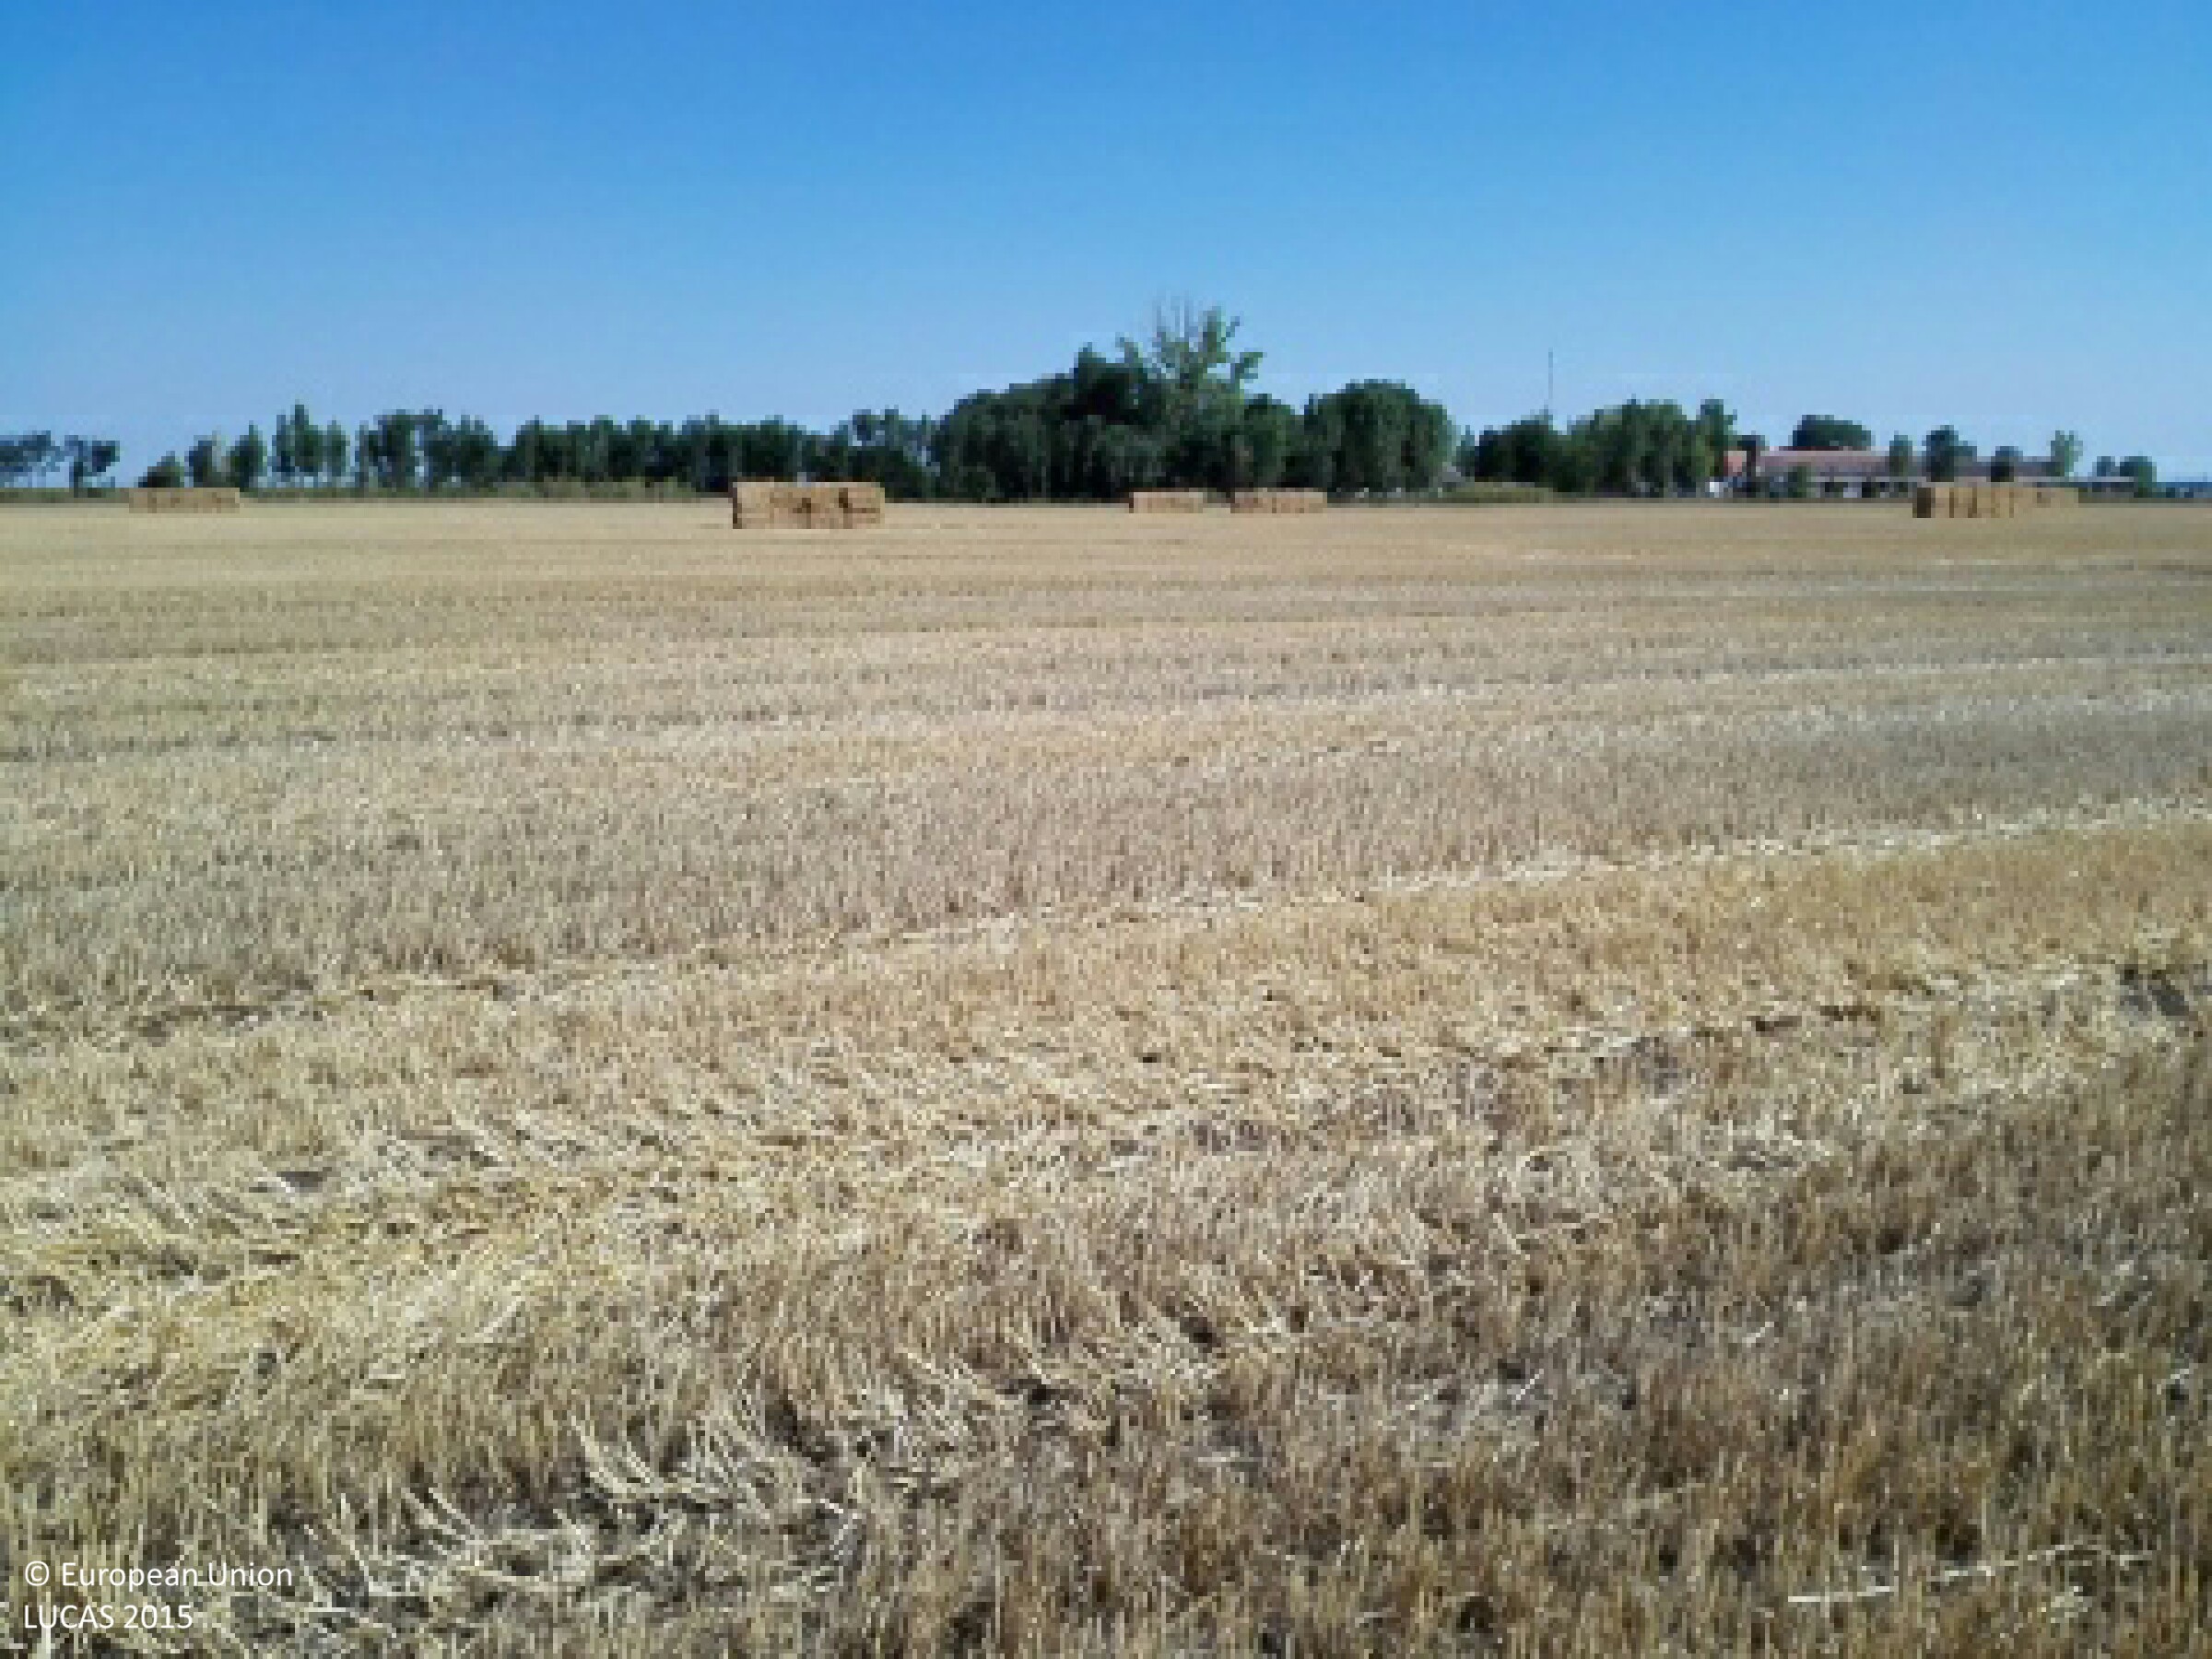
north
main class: Cropland
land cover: Common wheat
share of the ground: 50 - 75 %
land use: Agriculture (excluding fallow land and kitchen gardens)
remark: Harvested field
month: July
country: HU
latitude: 47.7139
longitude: 21.4666
